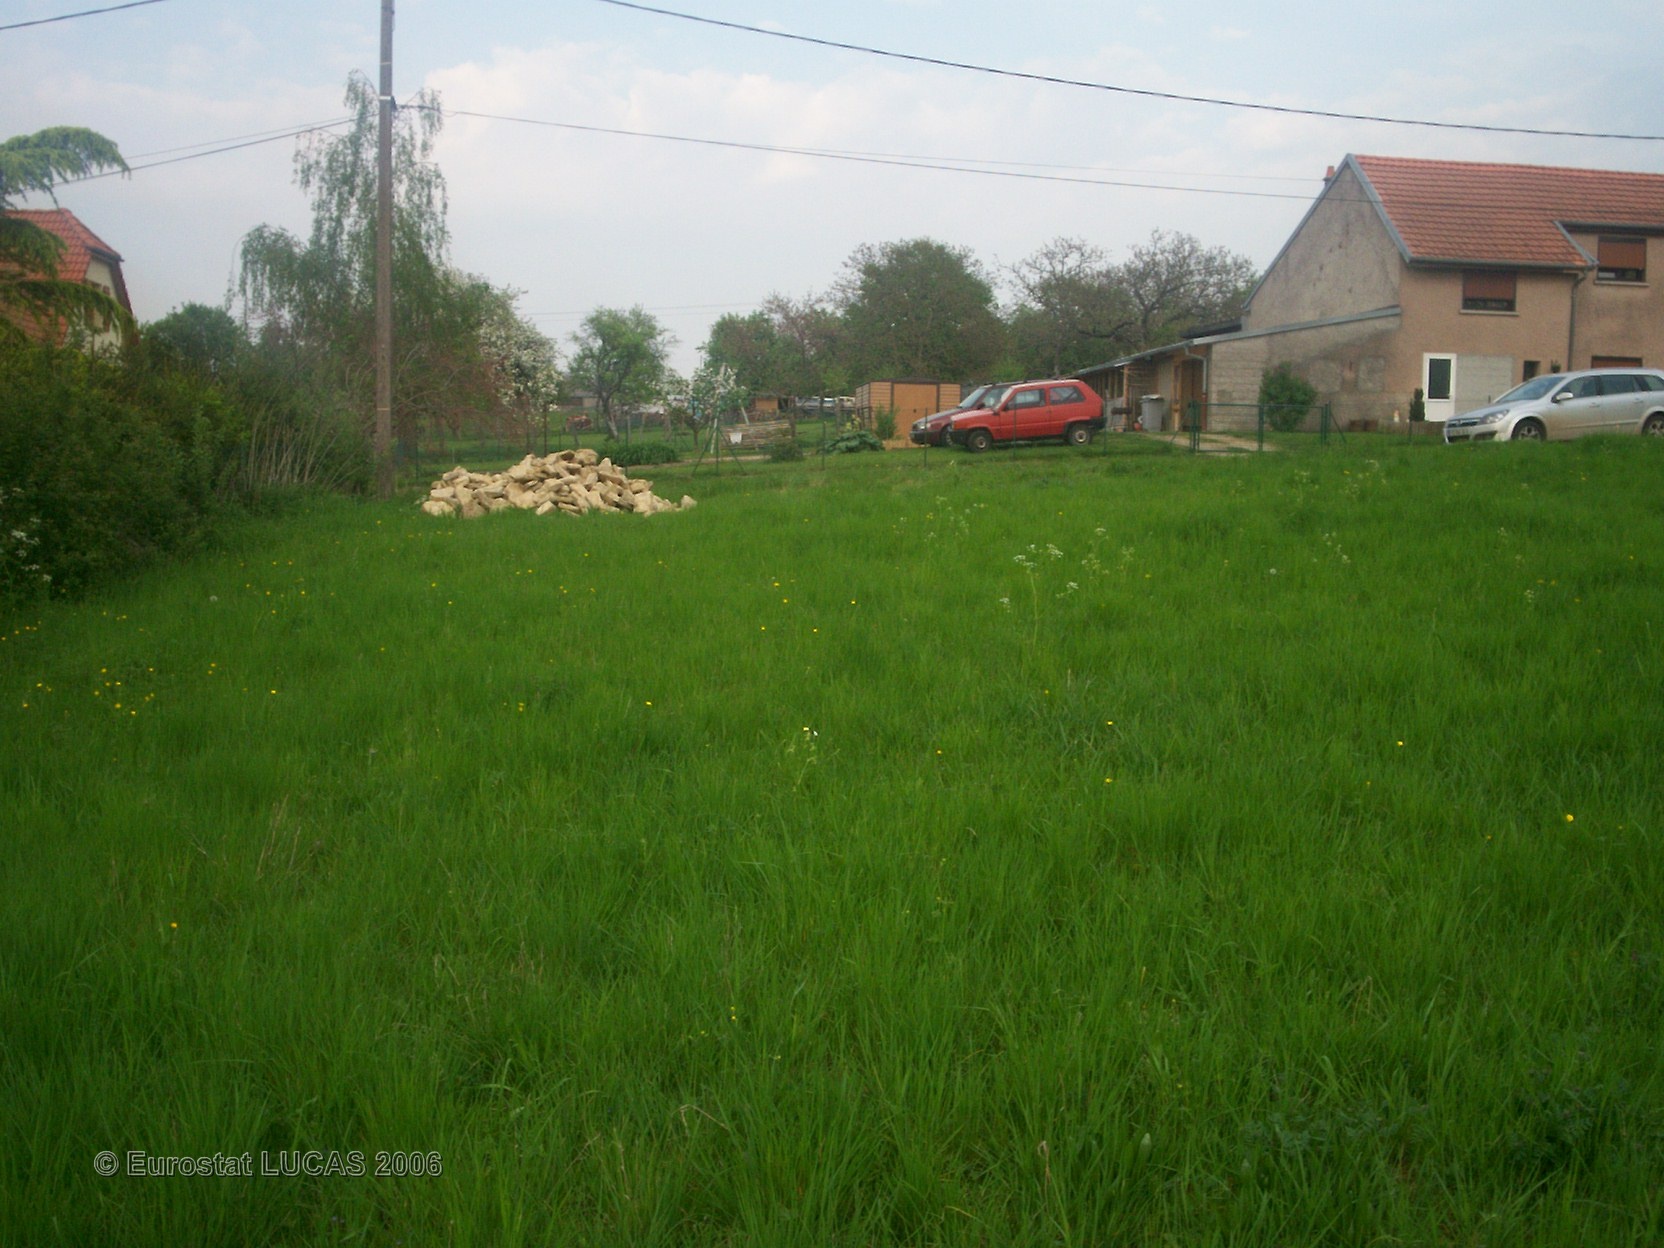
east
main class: Grassland
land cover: Grassland with sparse tree/shrub cover
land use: Agriculture (excluding fallow land and kitchen gardens)
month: May
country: FR
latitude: 48.7775
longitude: 7.0204
